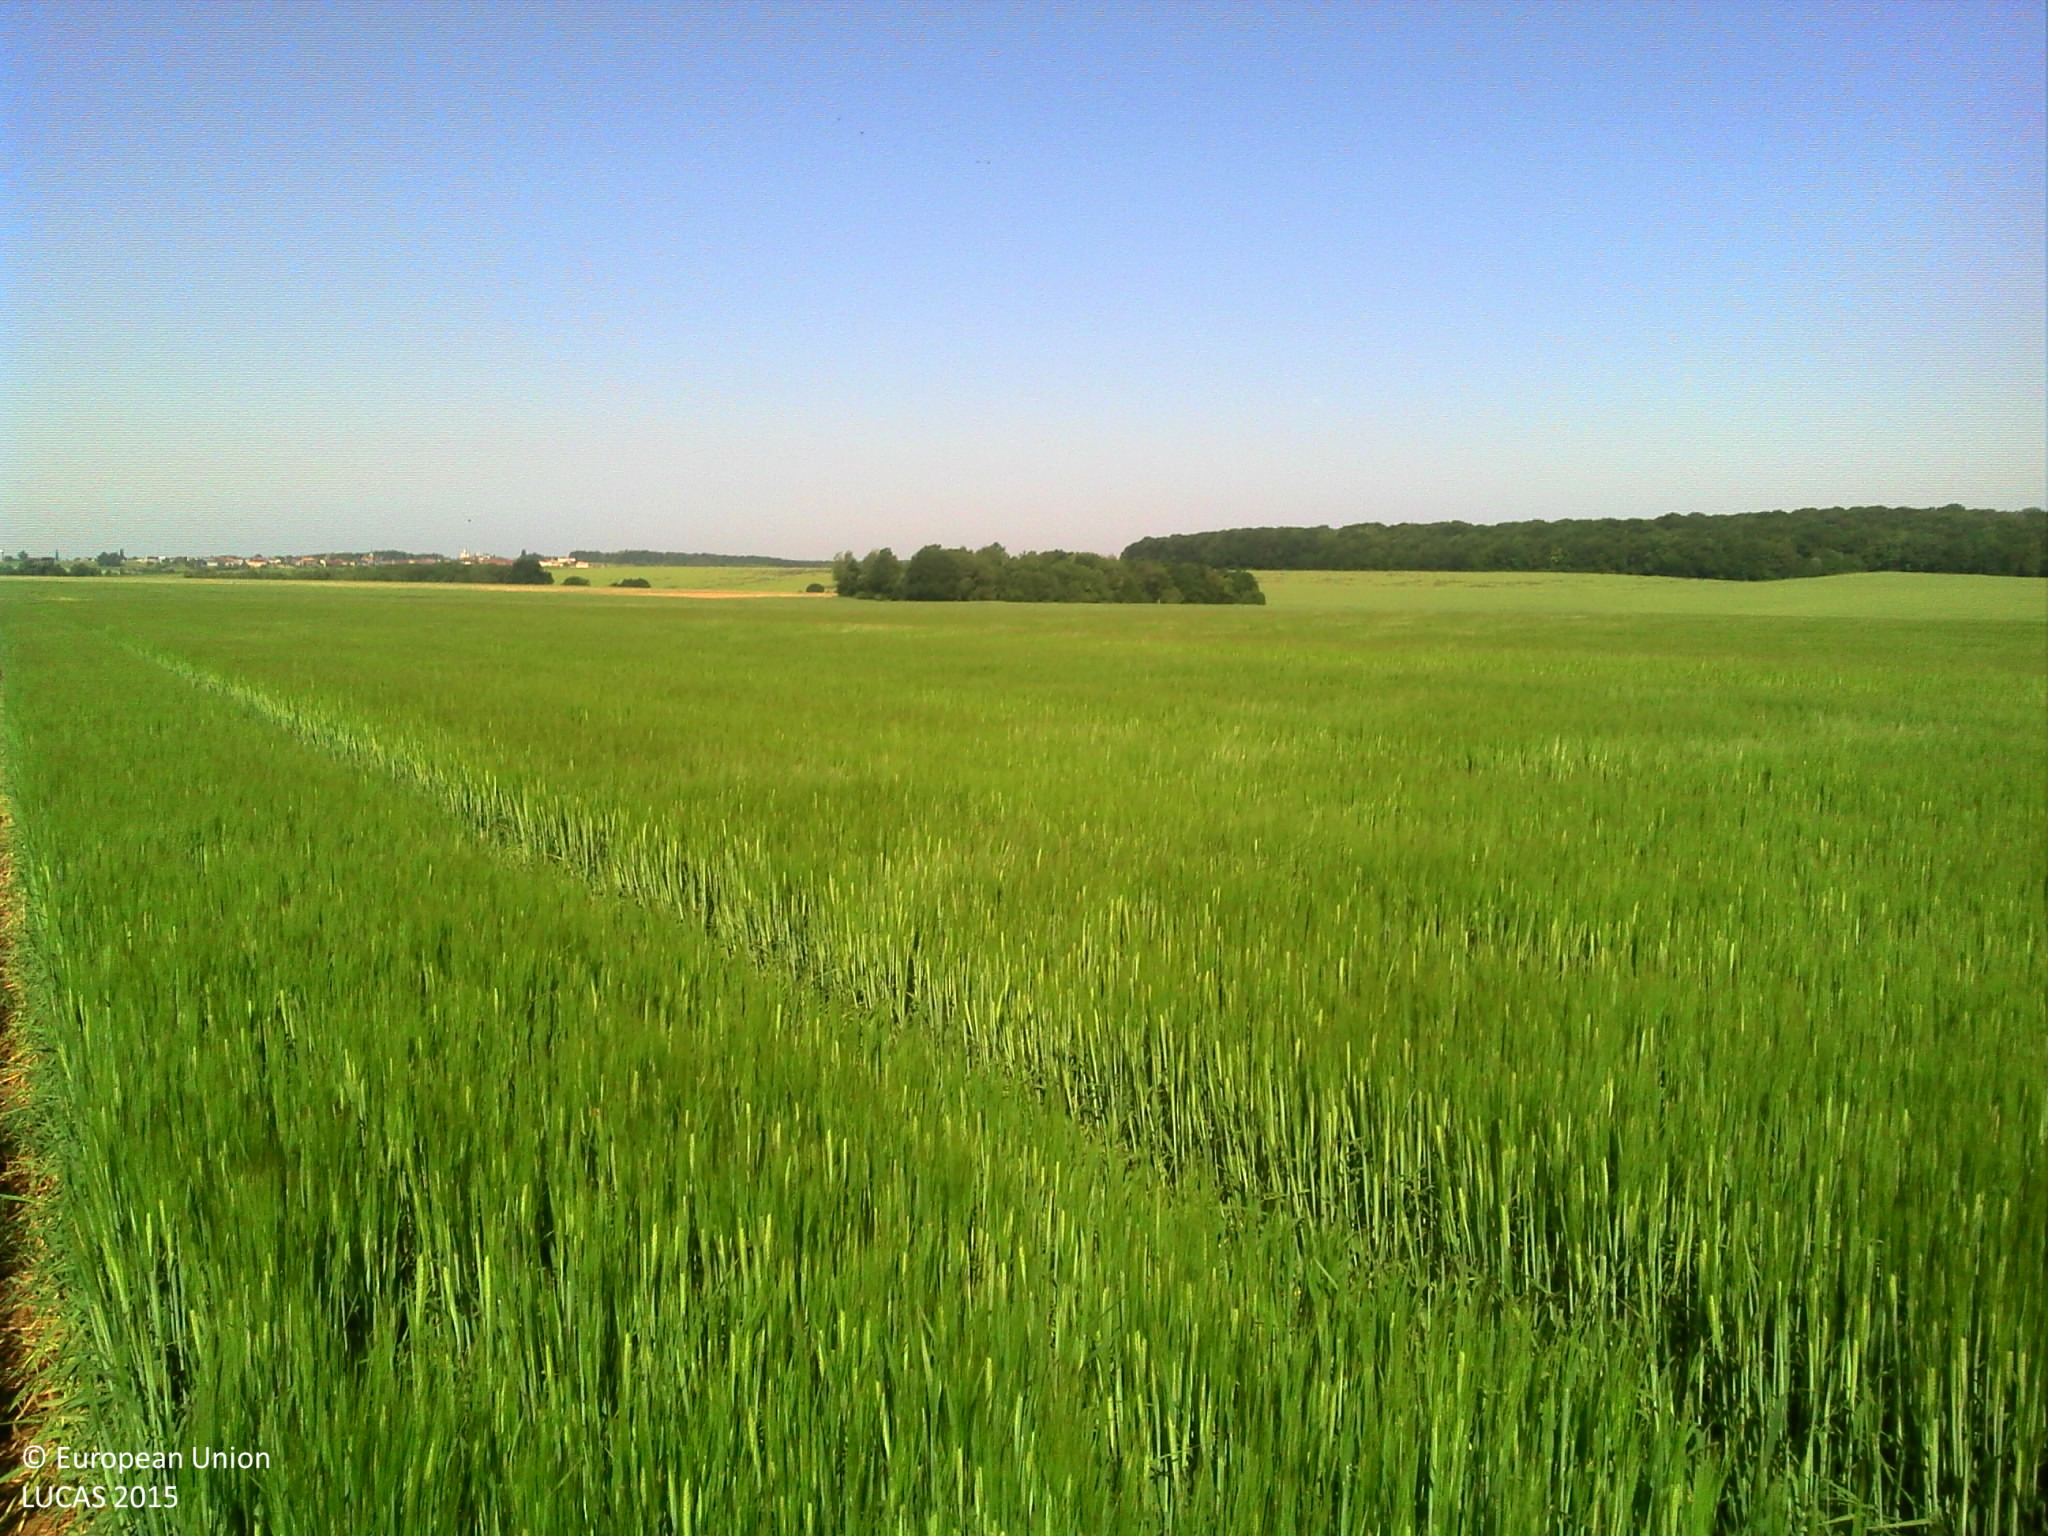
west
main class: Cropland
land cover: Barley
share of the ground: > 75 %
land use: Agriculture (excluding fallow land and kitchen gardens)
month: June
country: FR
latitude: 48.3739
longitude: 4.8547
